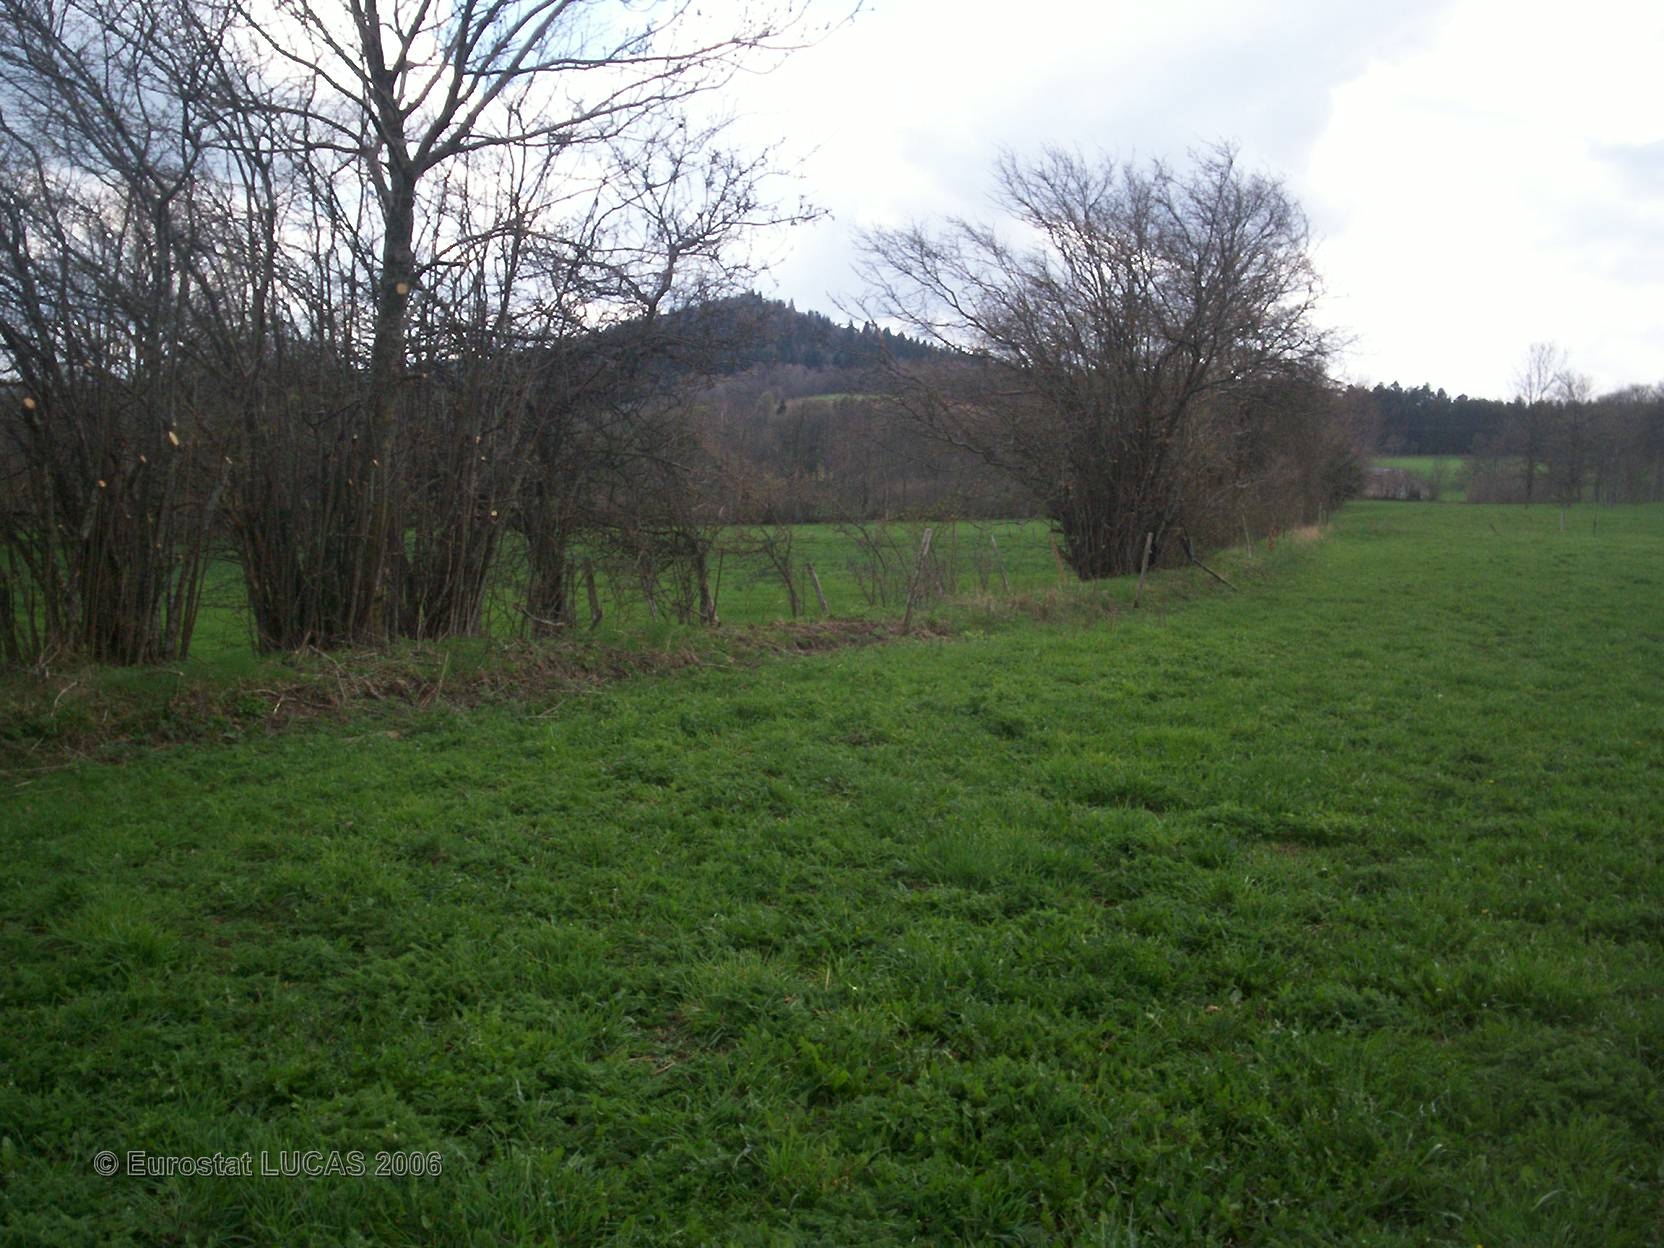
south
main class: Grassland
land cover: Grassland without tree/shrub cover
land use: Agriculture (excluding fallow land and kitchen gardens)
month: April
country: FR
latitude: 45.0919
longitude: 4.1978
